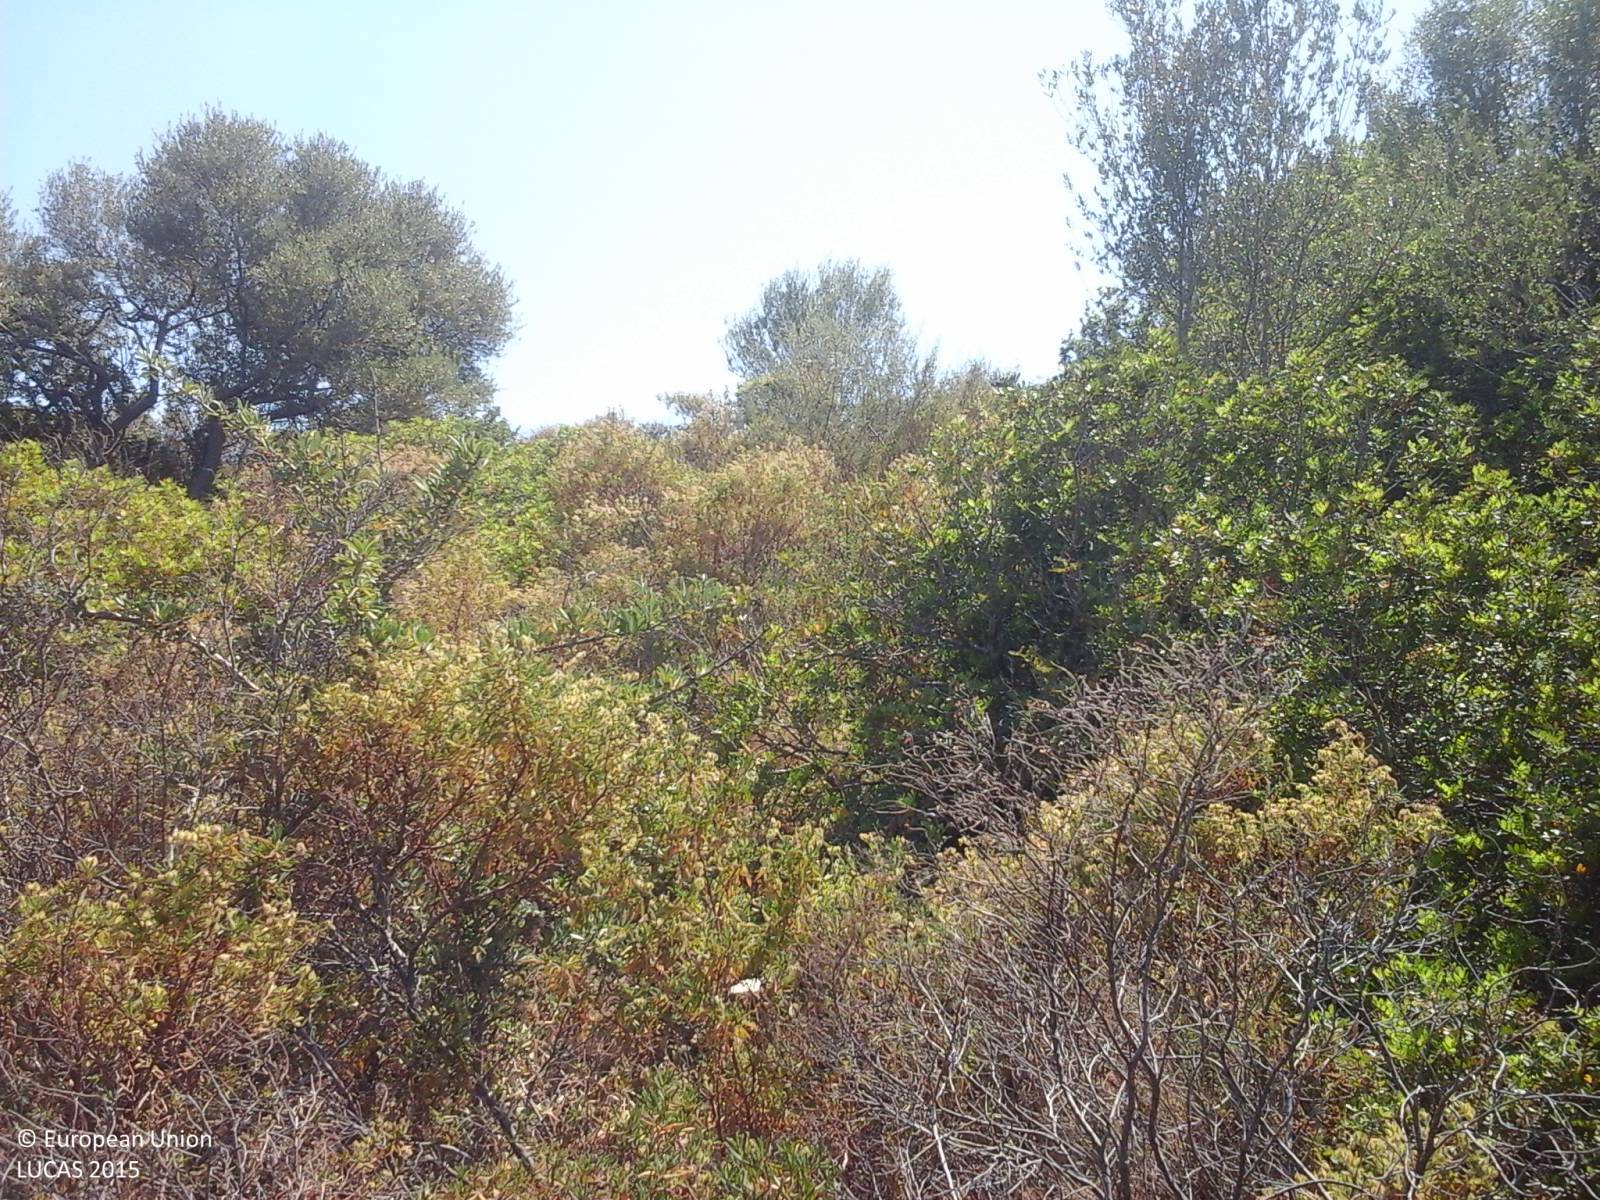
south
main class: Shrubland
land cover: Shrubland with sparse tree cover
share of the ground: 25 - 50 %
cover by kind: shrubs 70 %, herbaceous plants 25 %, broadleaved forest trees 5 %
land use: Agriculture (excluding fallow land and kitchen gardens)
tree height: > 5 m
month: June
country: IT
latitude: 38.9201
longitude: 8.8655
